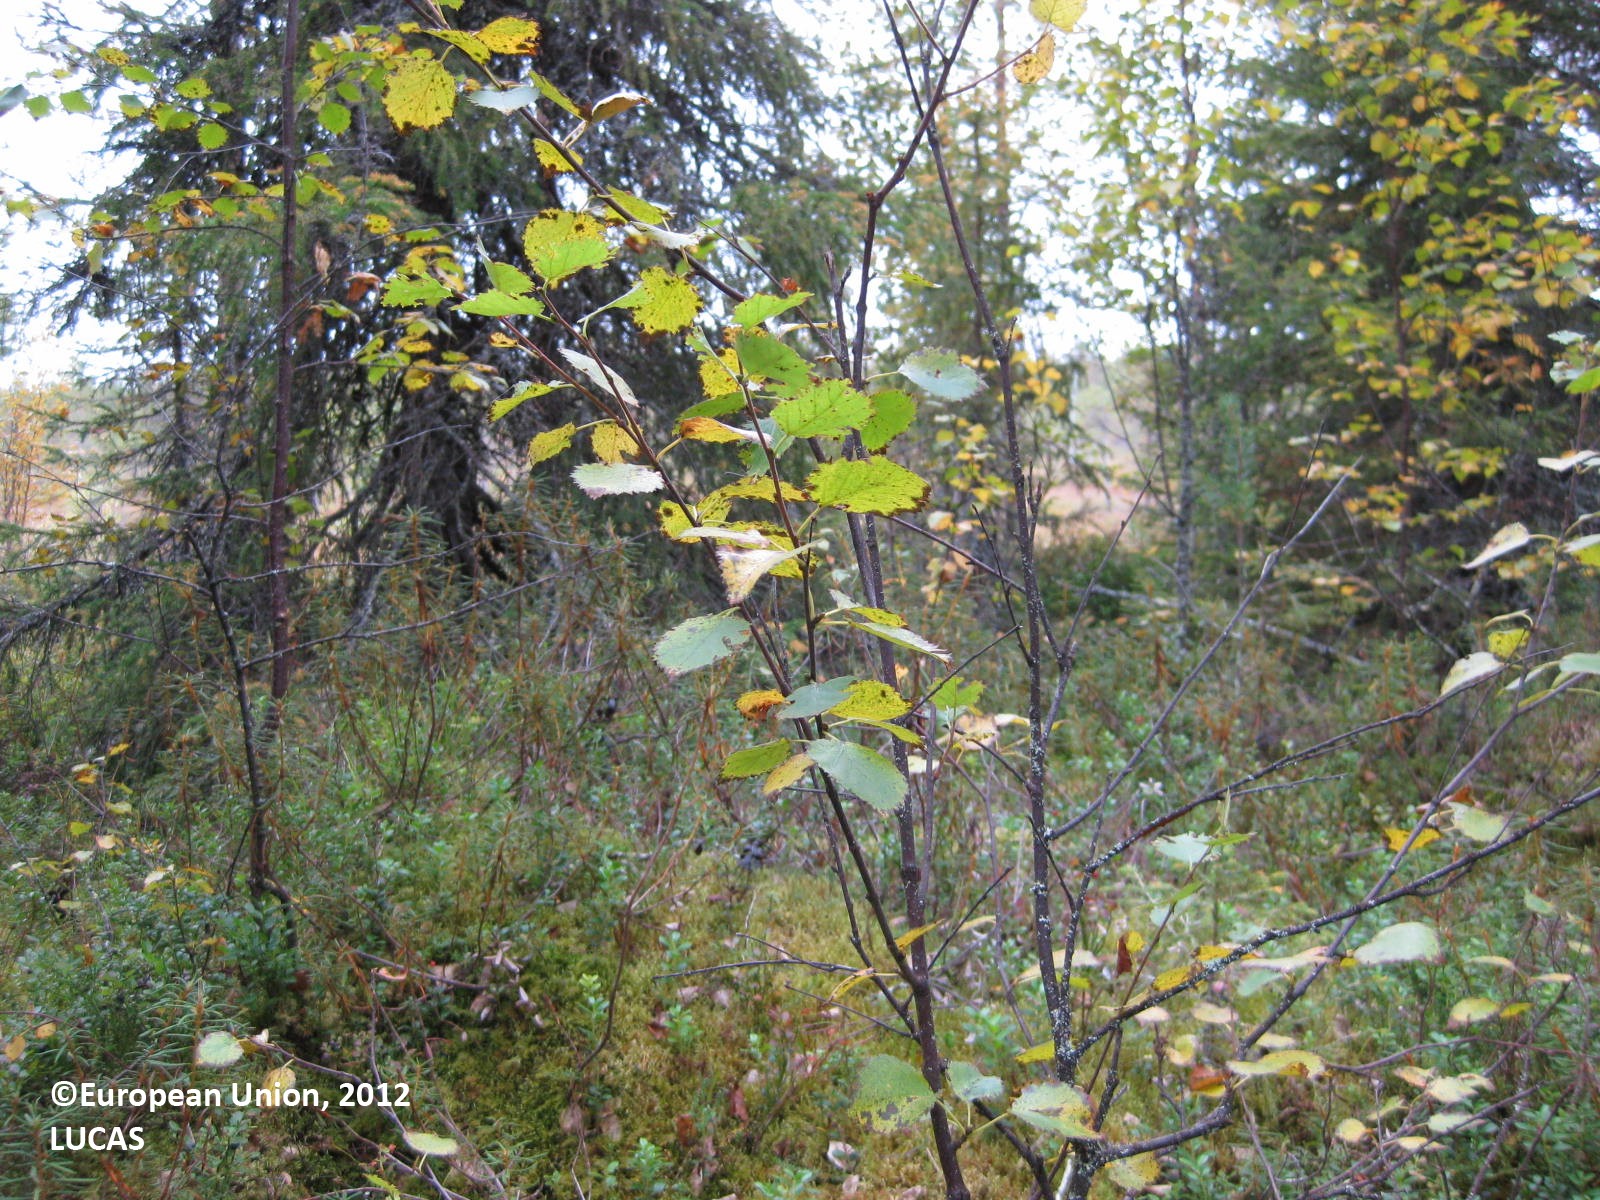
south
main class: Woodland
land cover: Other mixed woodland
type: boreal forest
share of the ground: 50 - 75 %
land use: Forestry
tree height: > 5 m
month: August
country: FI
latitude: 65.9650
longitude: 29.8079
